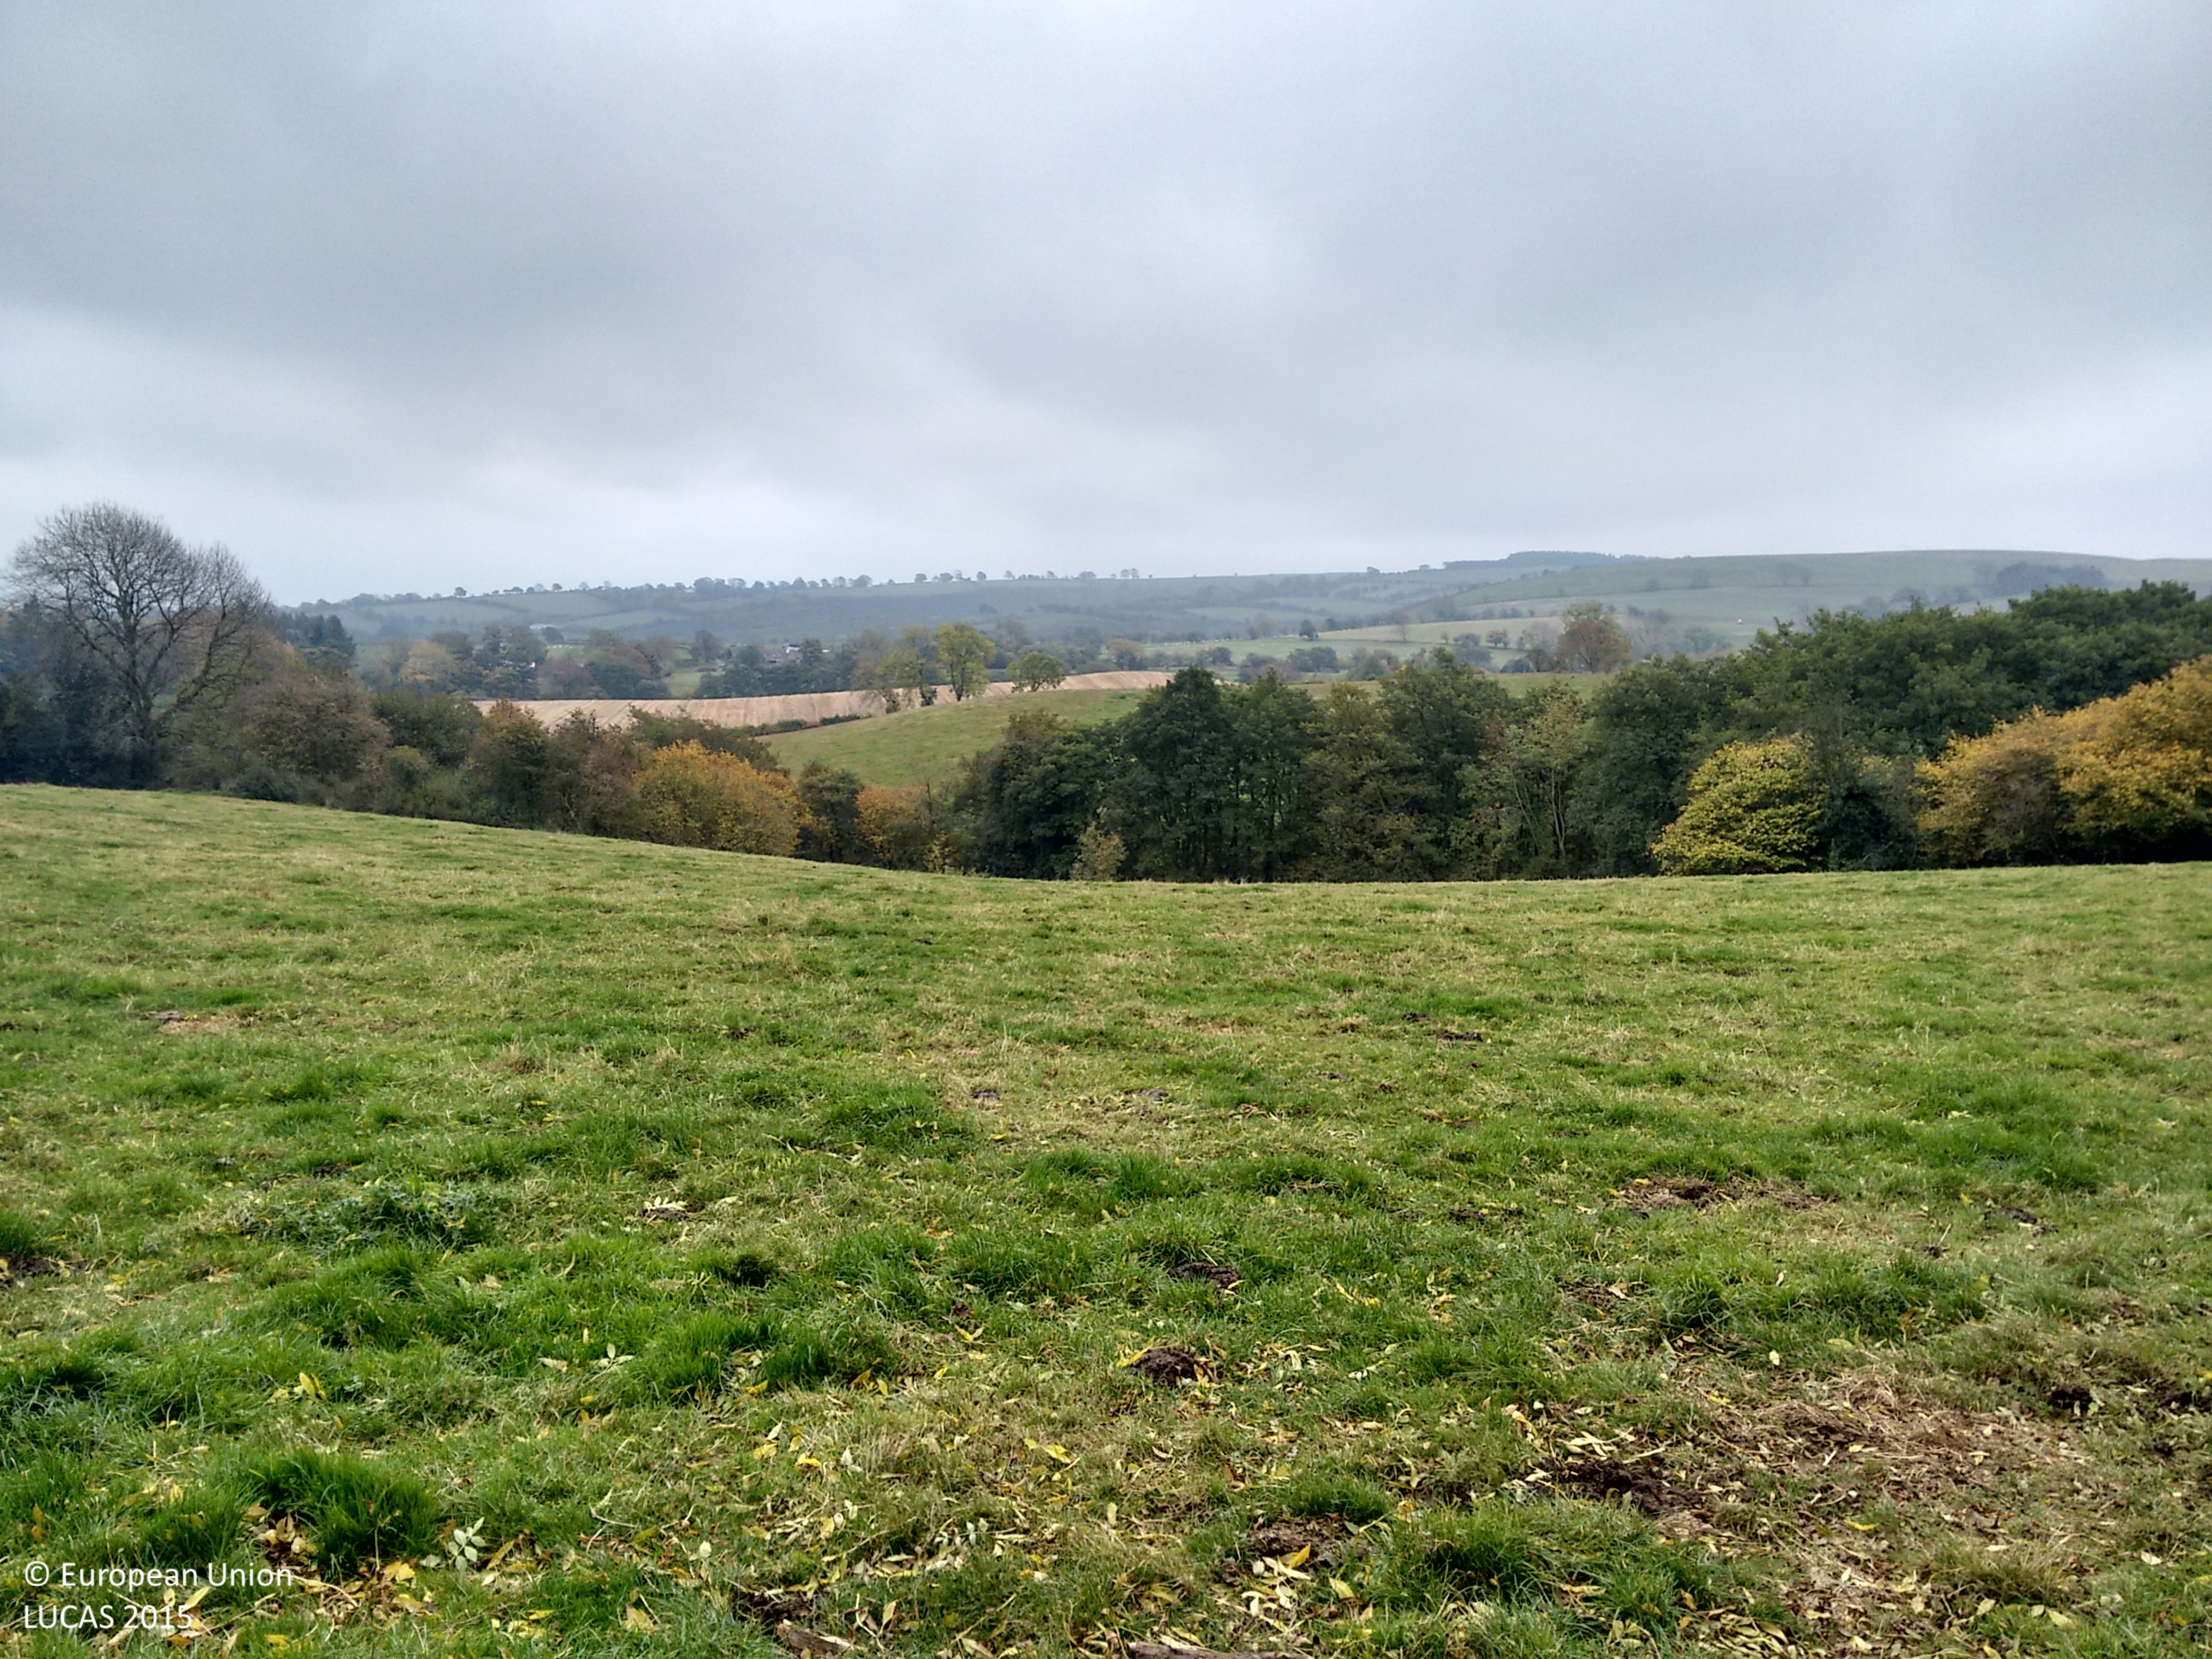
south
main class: Grassland
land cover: Grassland without tree/shrub cover
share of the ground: > 75 %
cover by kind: herbaceous plants 100 %
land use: Agriculture (excluding fallow land and kitchen gardens)
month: October
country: GB
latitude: 52.5873
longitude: -2.8395
